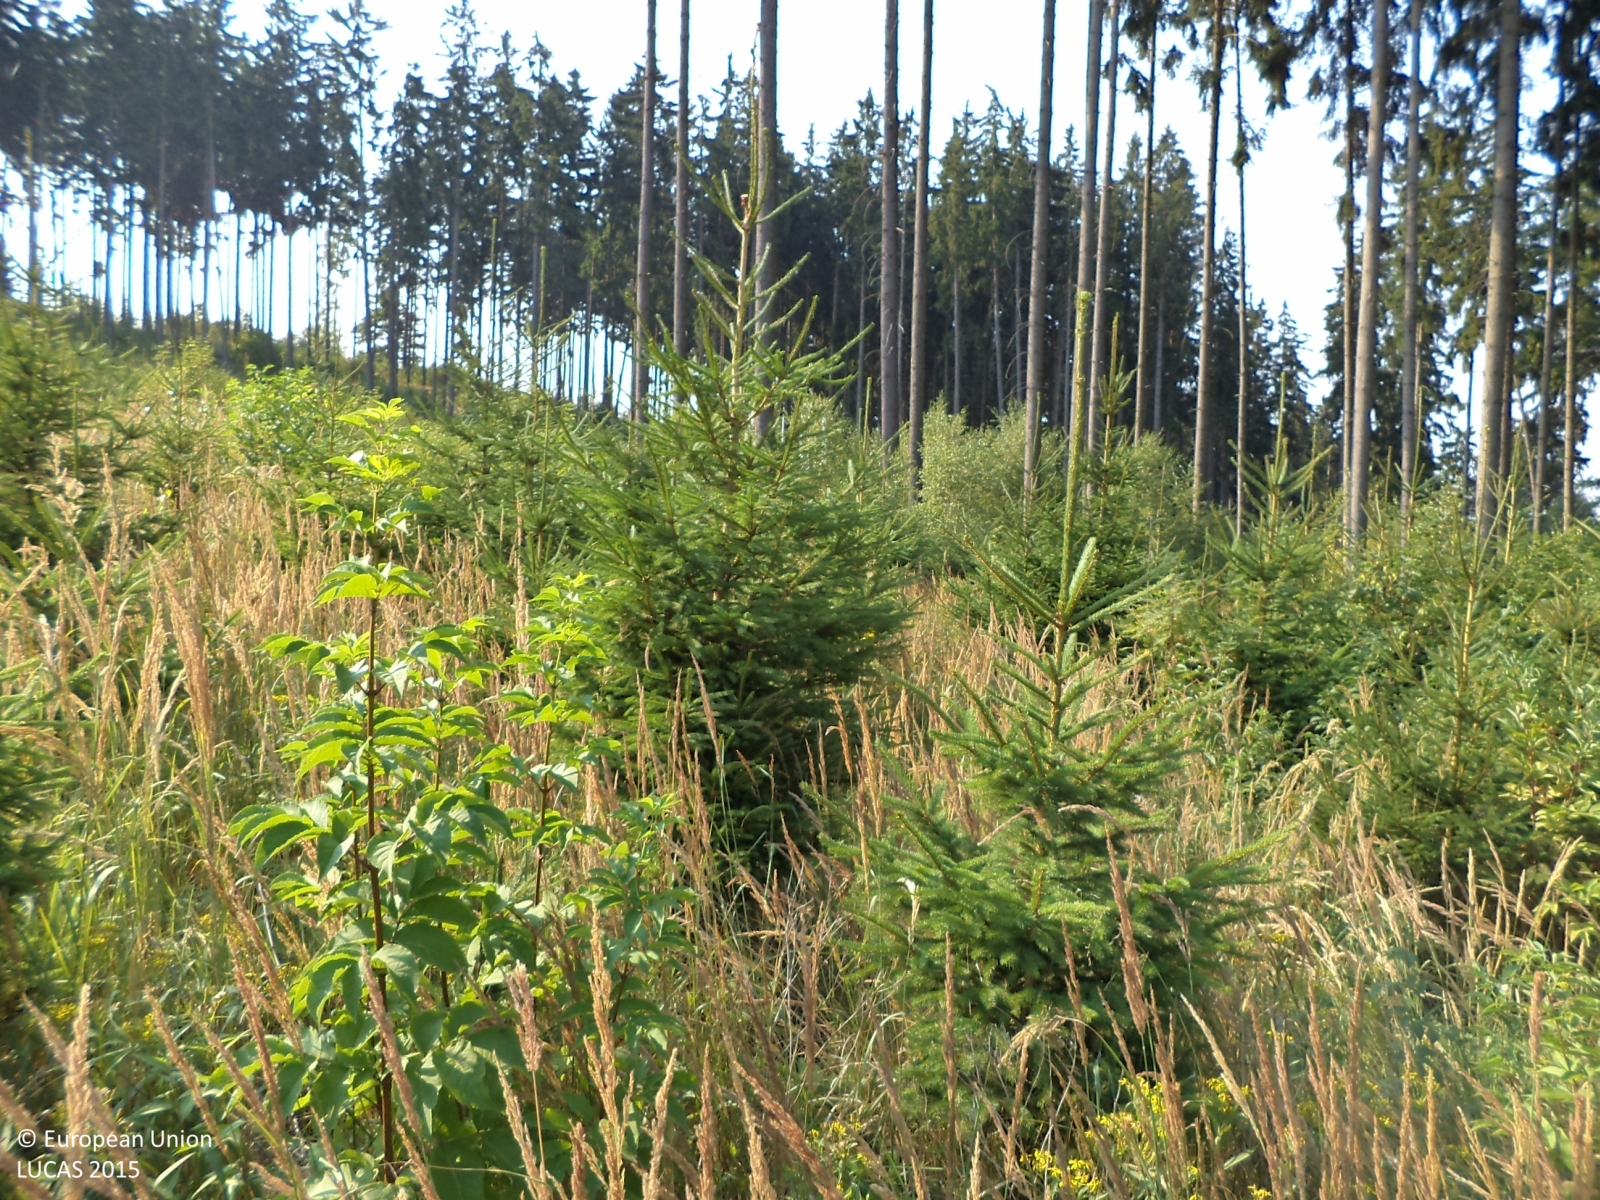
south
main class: Woodland
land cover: Spruce dominated coniferous woodland
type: hemiboreal forest and nemoral coniferous forest and mixed broadleaved-coniferous forest
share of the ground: > 75 %
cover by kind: coniferous forest trees 80 %, herbaceous plants 20 %
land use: Forestry
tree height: > 5 m
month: August
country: CZ
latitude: 49.5205
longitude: 14.4633
